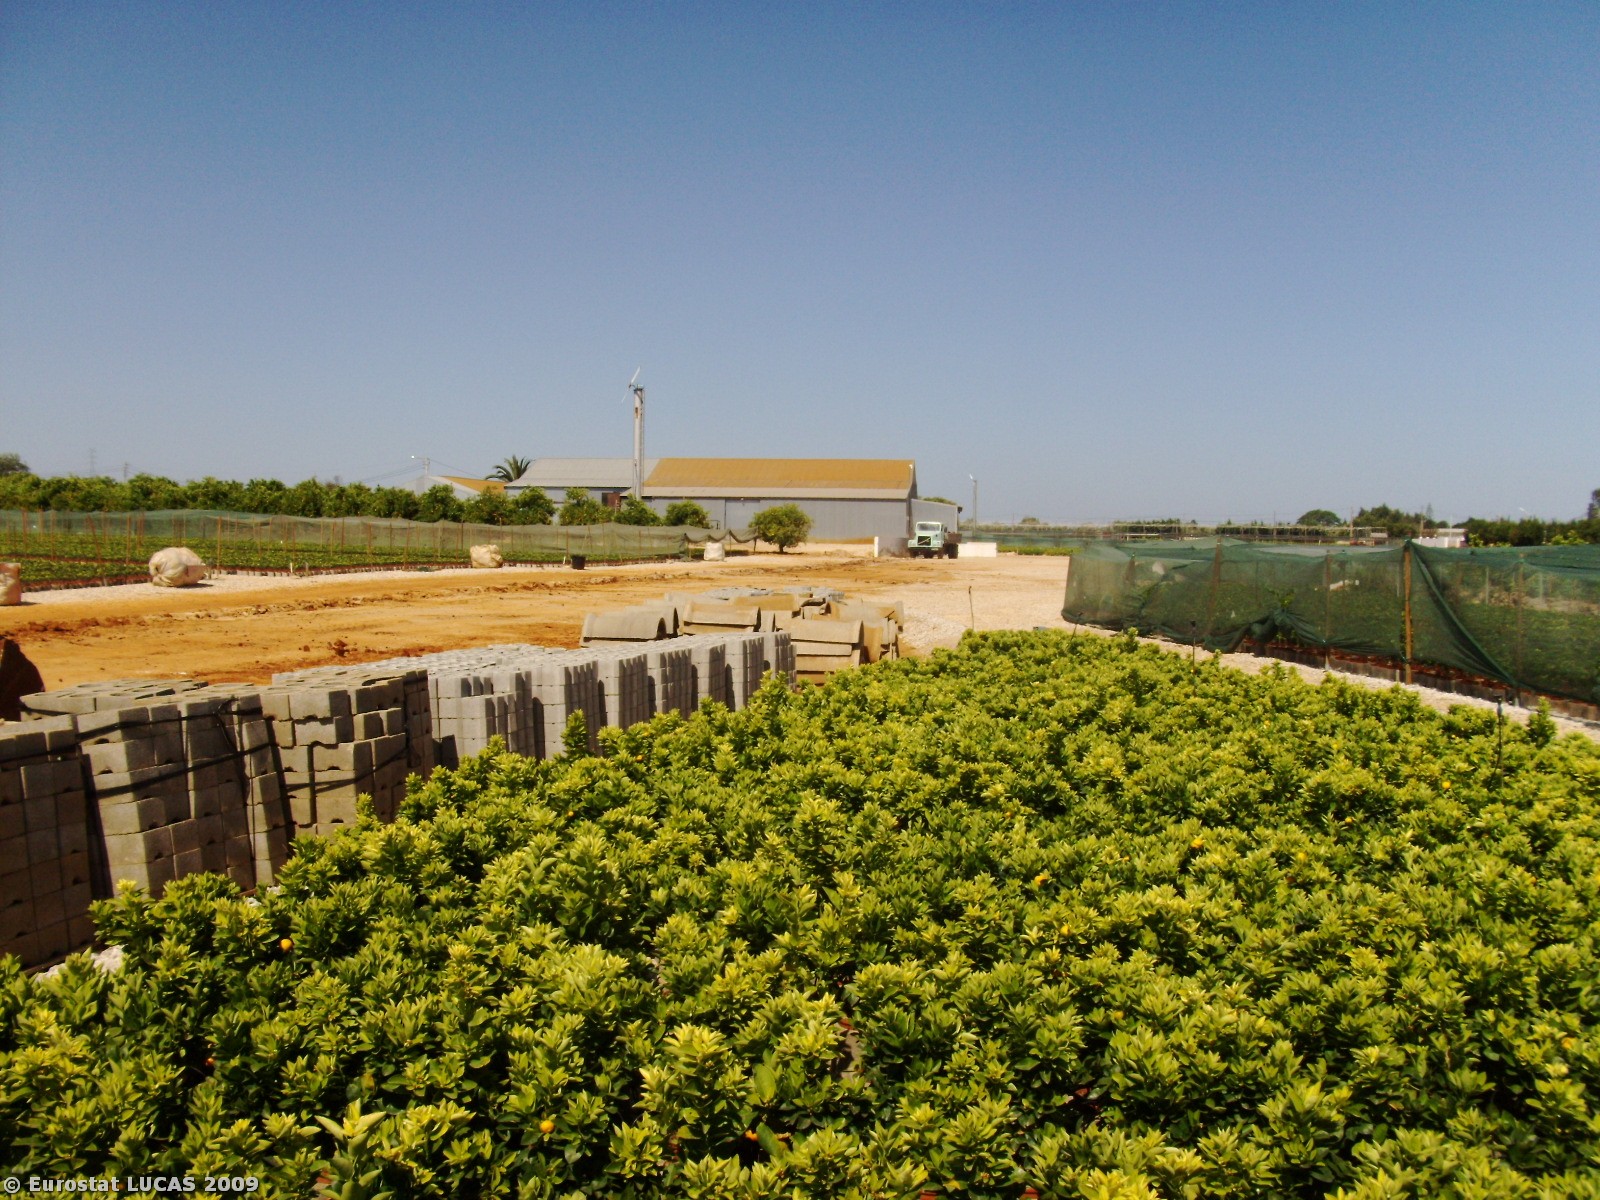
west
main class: Cropland
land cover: Nurseries
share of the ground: > 75 %
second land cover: Bare land
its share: < 10 %
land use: Agriculture (excluding fallow land and kitchen gardens)
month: May
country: PT
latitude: 37.1909
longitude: -8.2352
